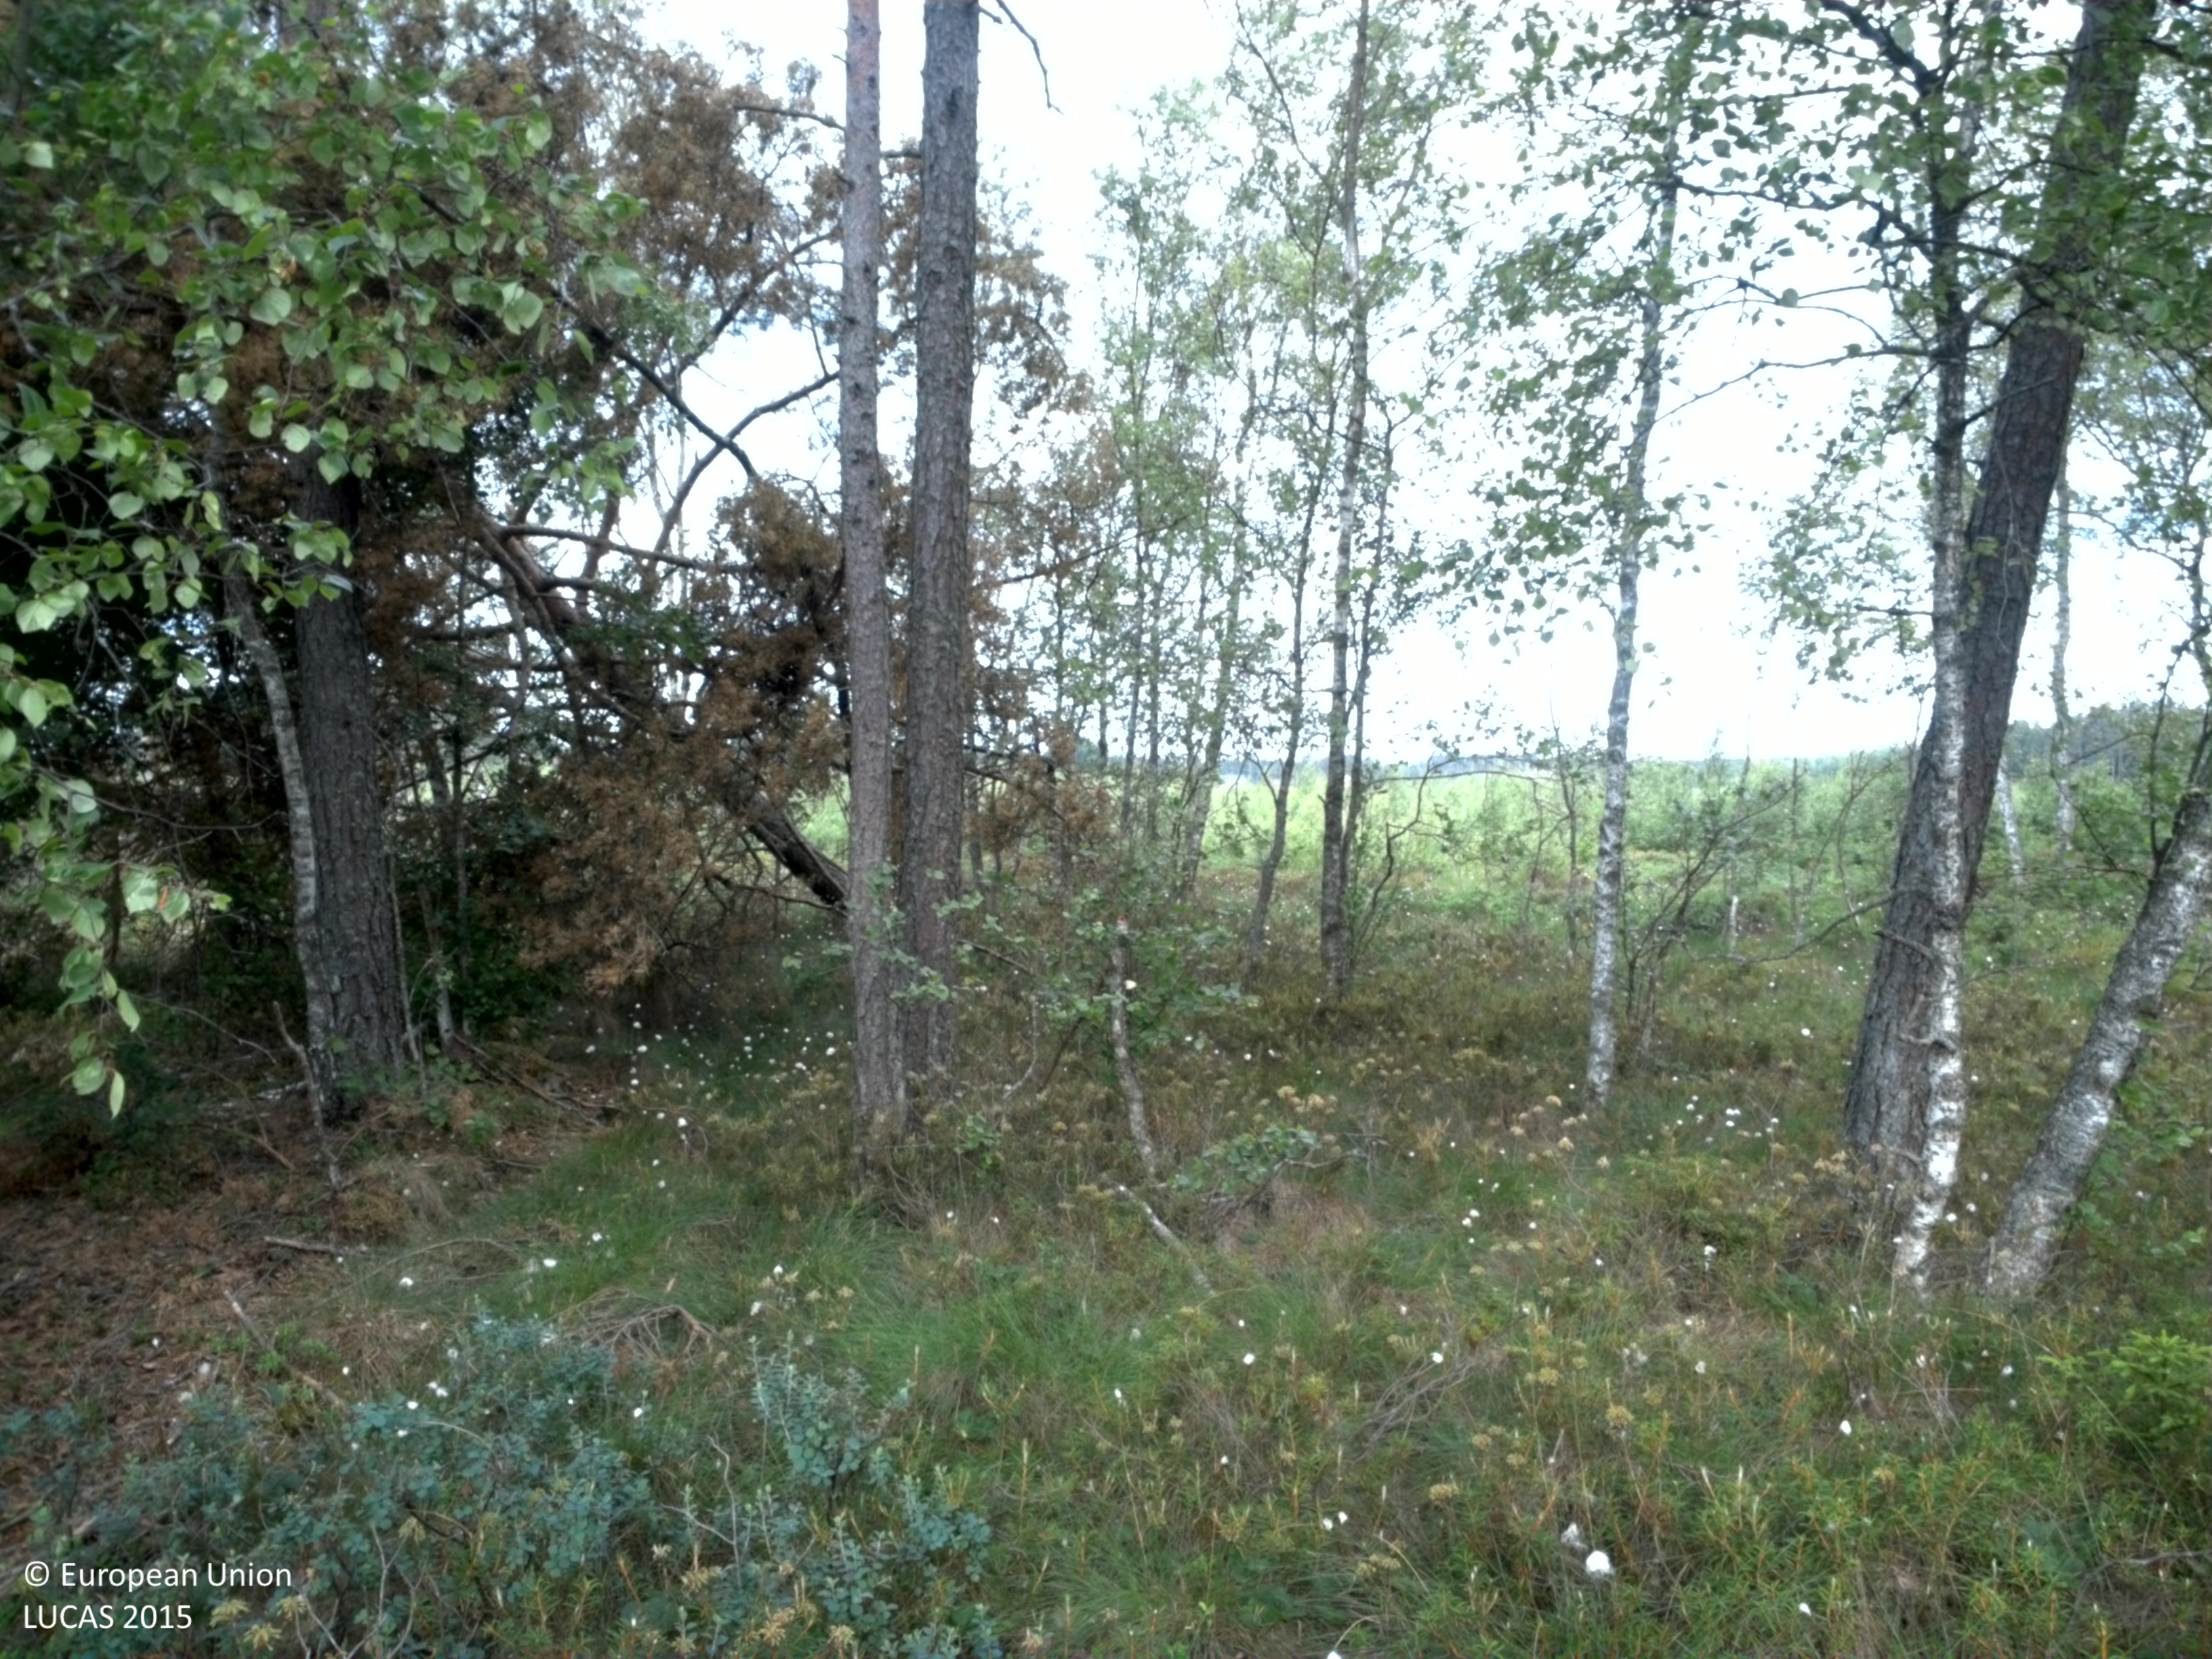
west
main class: Woodland
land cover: Pine dominated mixed woodland
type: boreal forest
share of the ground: 50 - 75 %
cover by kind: coniferous forest trees 35 %, broadleaved forest trees 25 %, shrubs 25 %, lichens and mosses 15 %
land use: Forestry
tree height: > 5 m
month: July
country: SE
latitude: 58.3579
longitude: 14.0100
